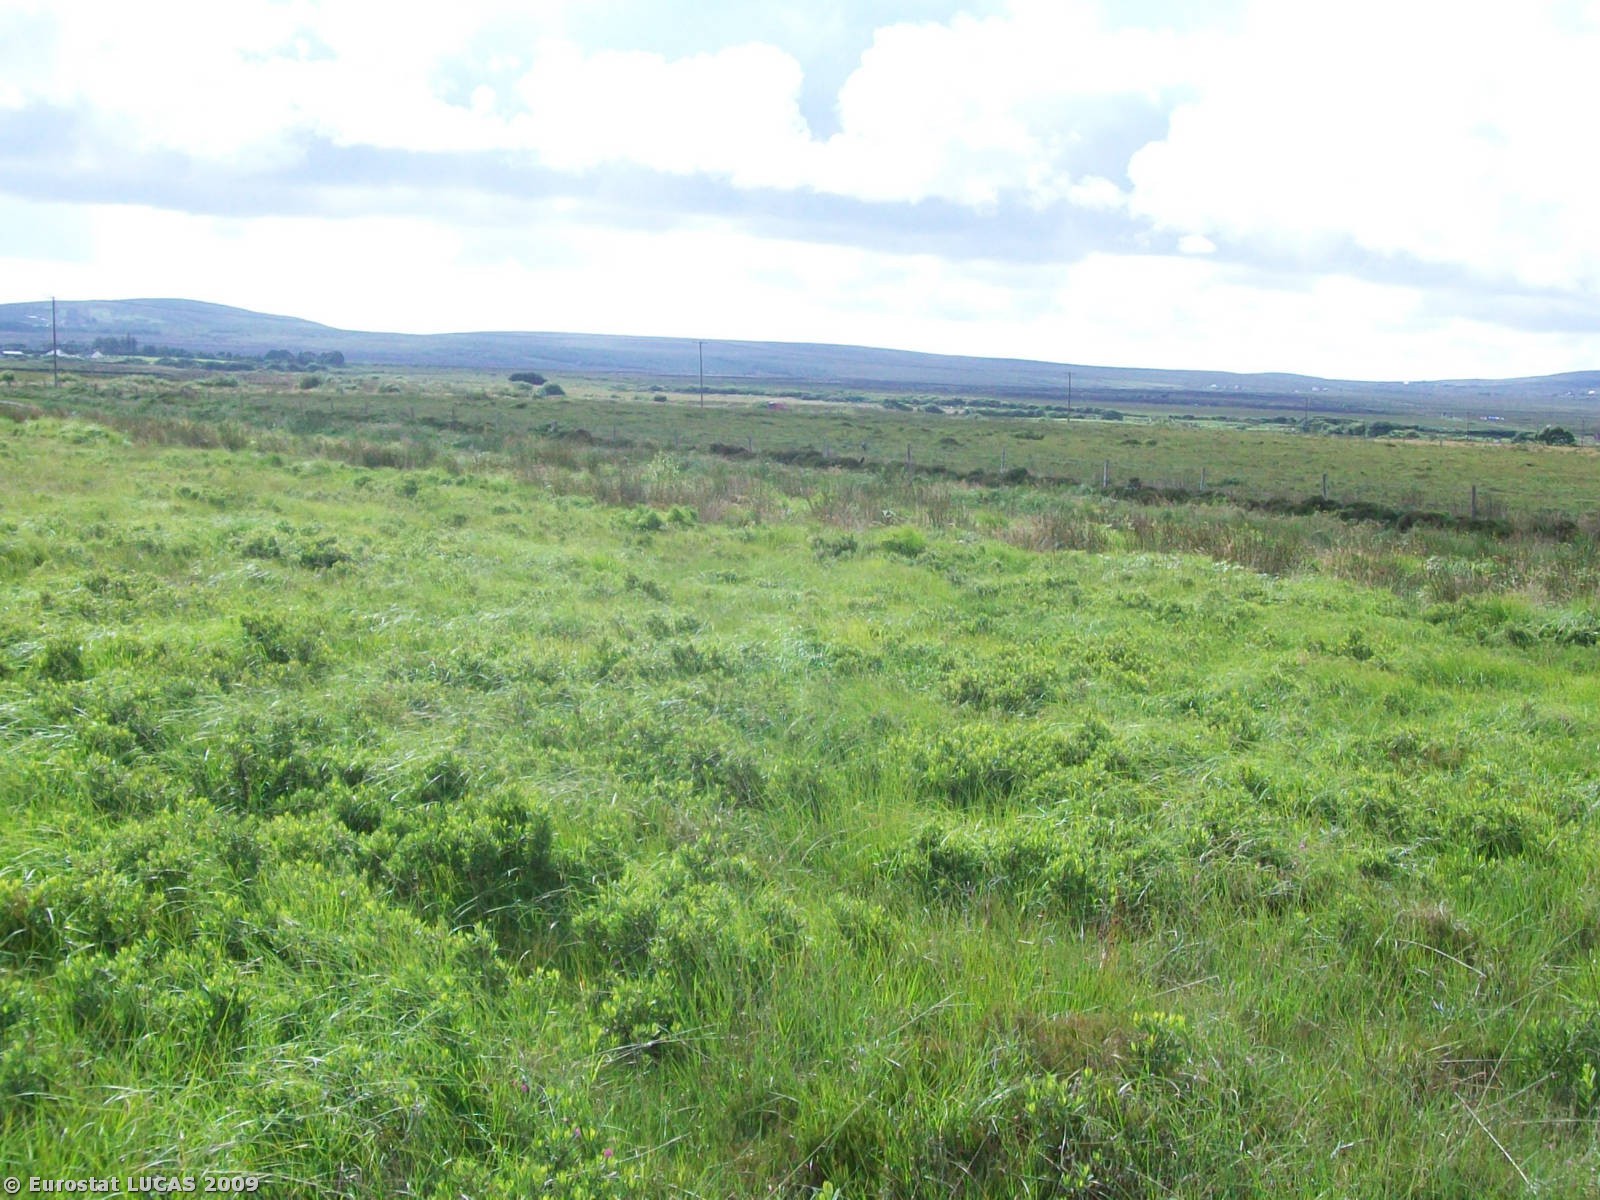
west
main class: Wetlands
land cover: Peatbogs
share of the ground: > 75 %
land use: Mining and quarrying
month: July
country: IE
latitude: 54.1600
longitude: -9.7687
